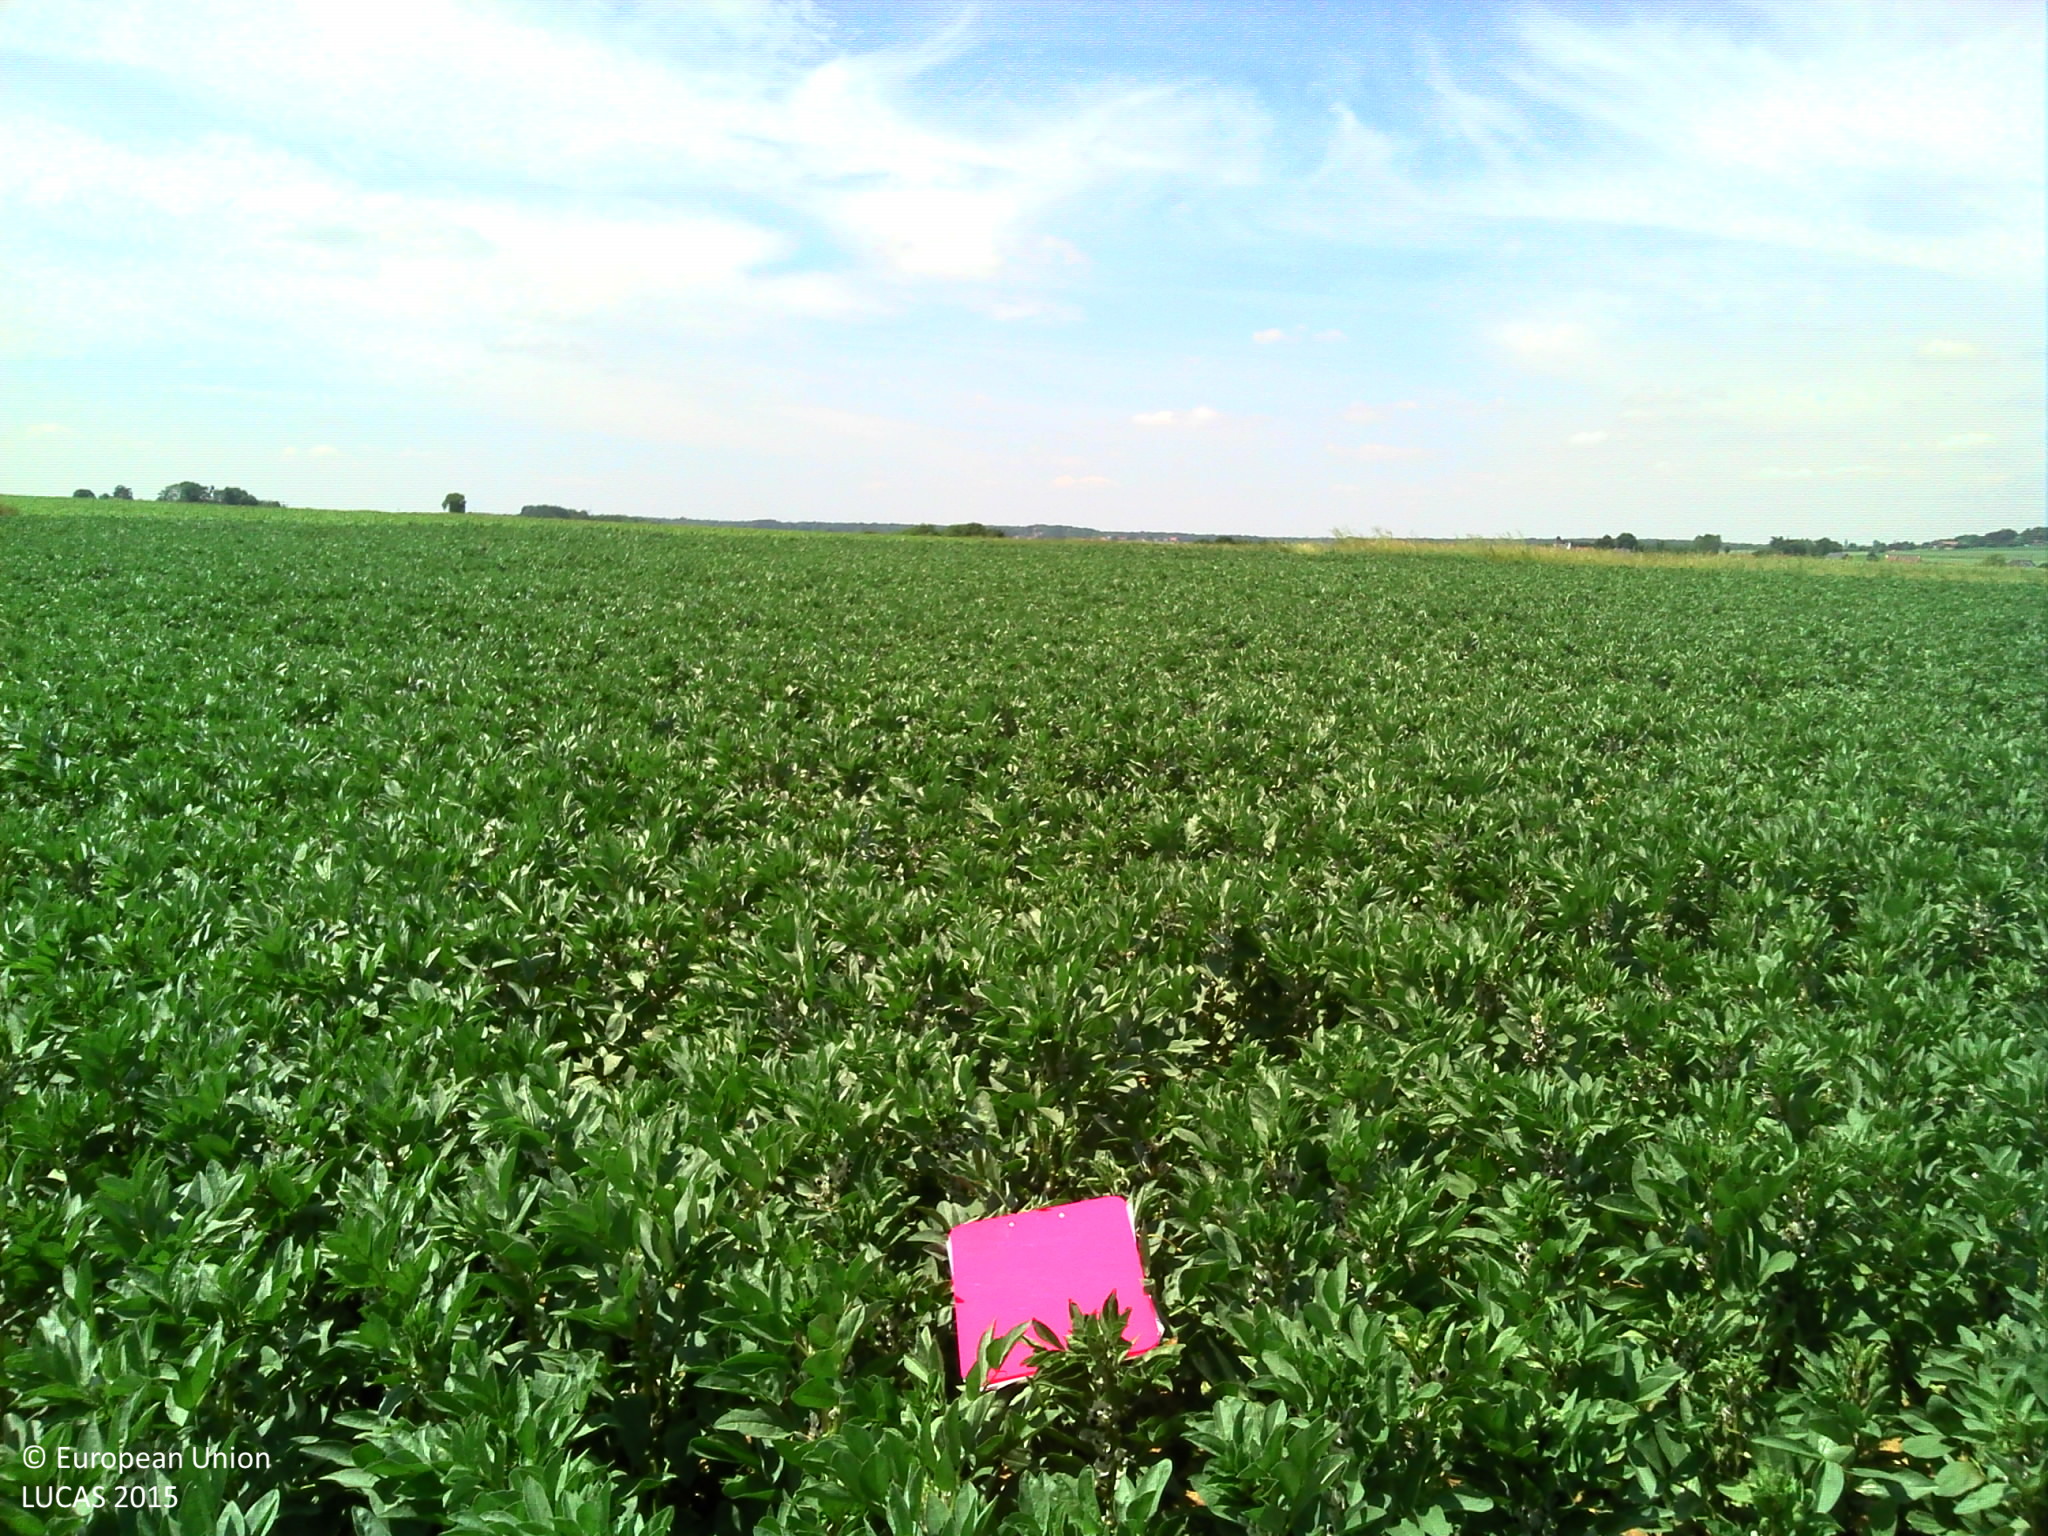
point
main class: Cropland
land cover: Dry pulses
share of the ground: > 75 %
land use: Agriculture (excluding fallow land and kitchen gardens)
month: June
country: FR
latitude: 49.6299
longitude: 2.4978
